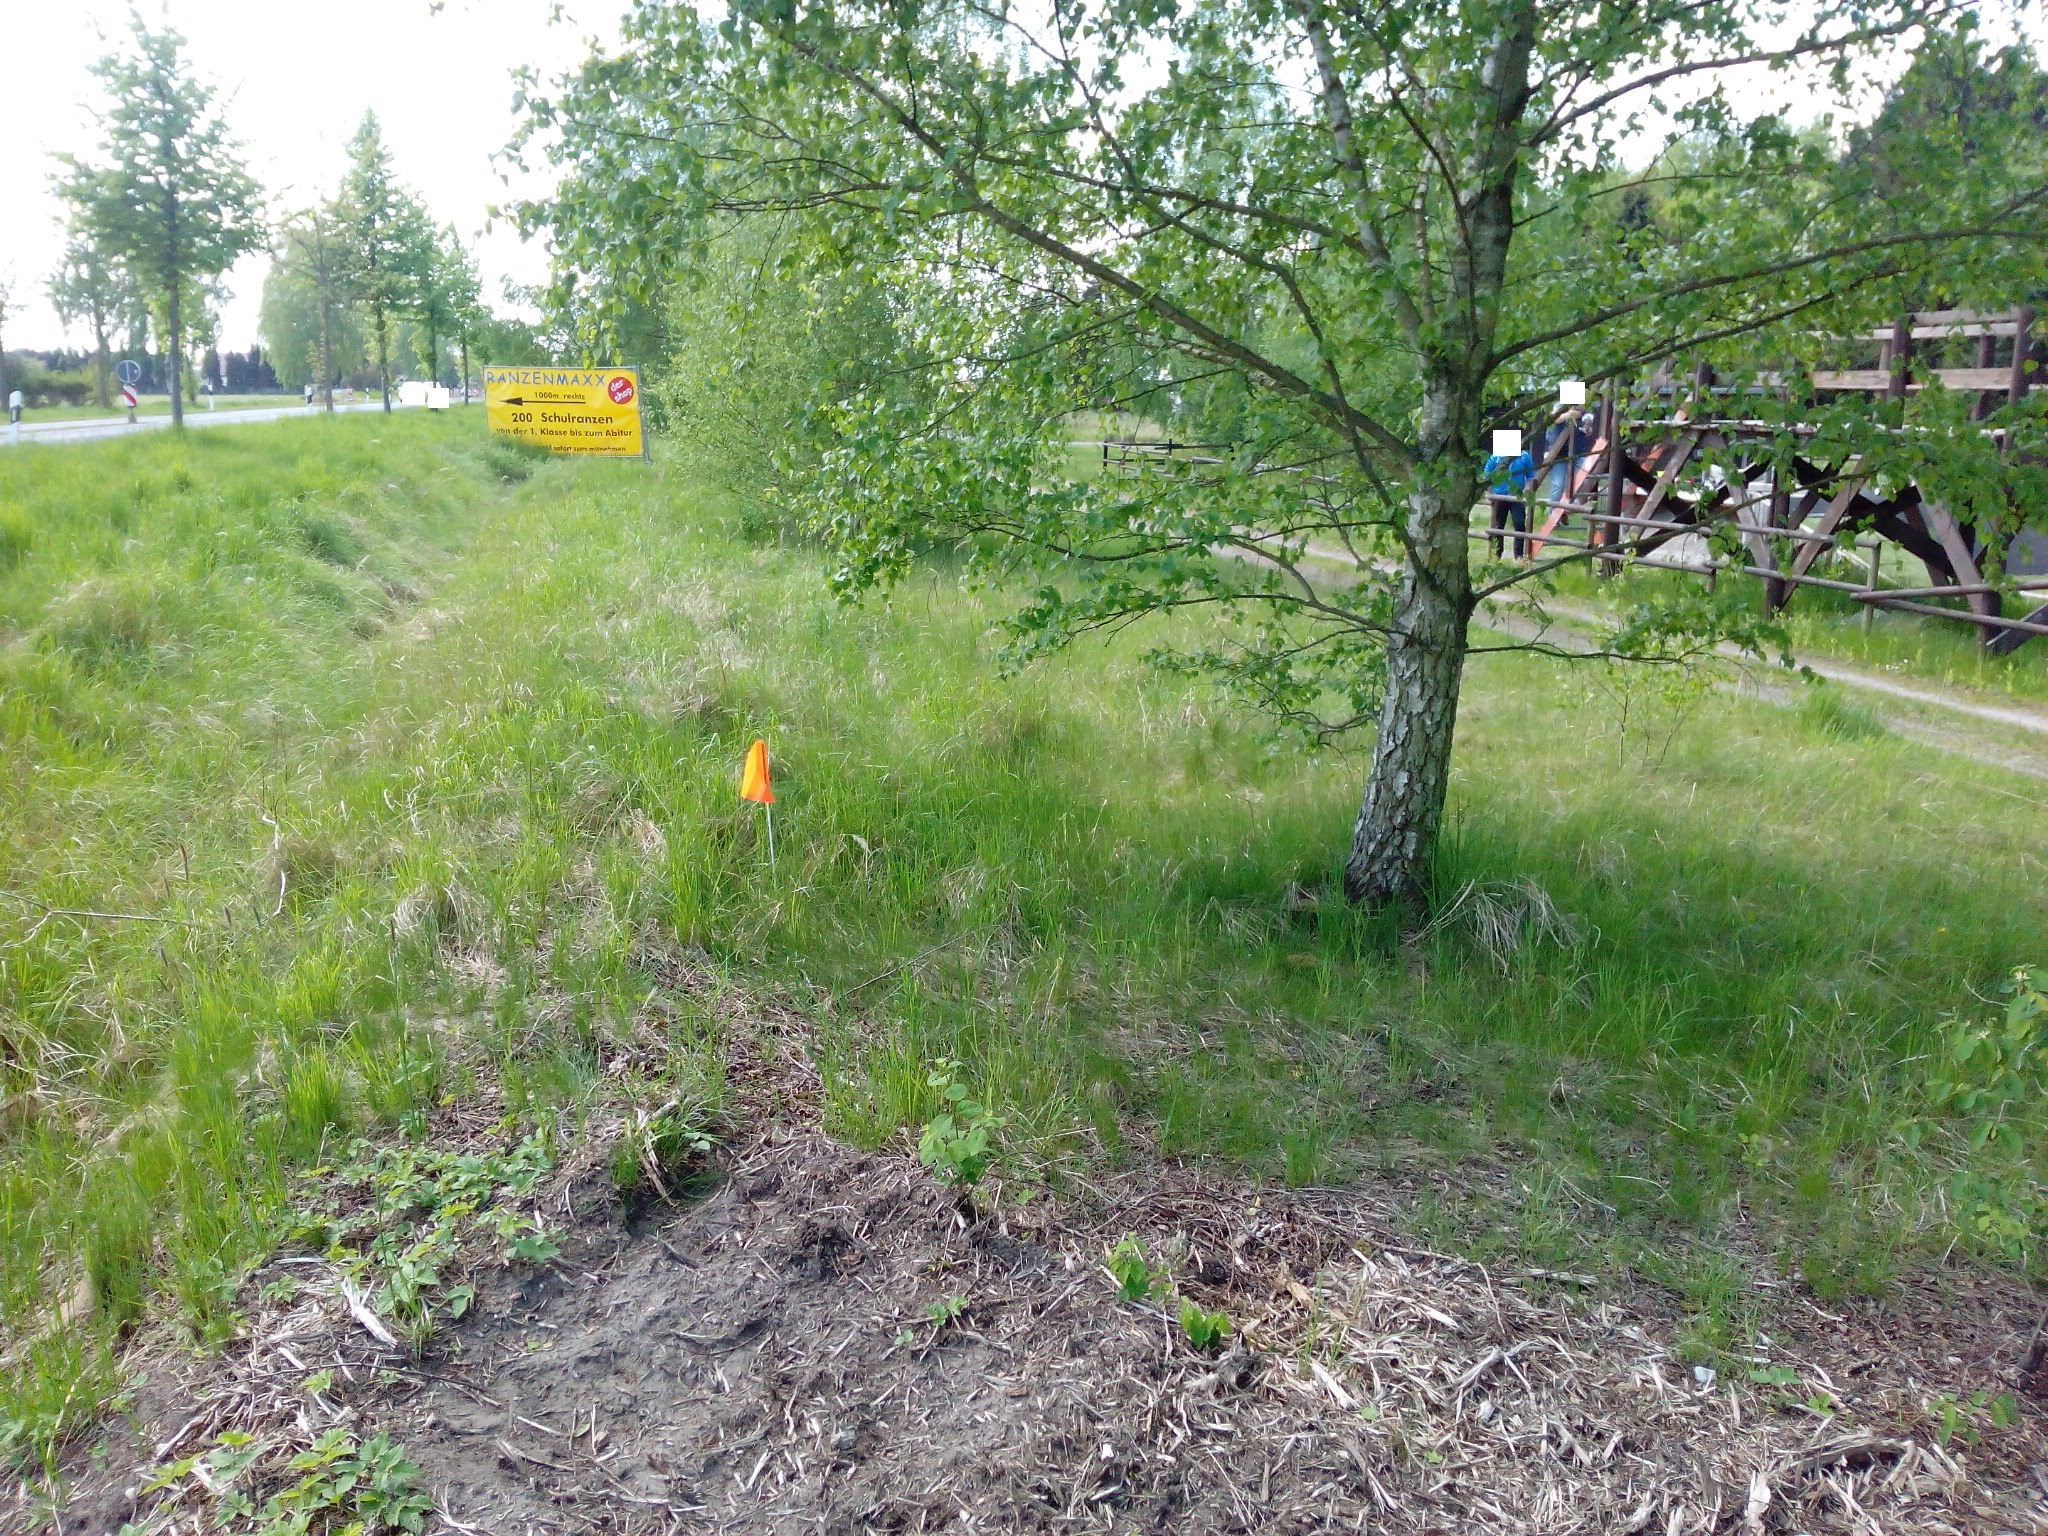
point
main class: Woodland
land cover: Broadleaved woodland
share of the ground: 50 - 75 %
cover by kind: broadleaved forest trees 70 %, herbaceous plants 15 %, consolidated bare surface 15 %
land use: Road transport
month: May
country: DE
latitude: 52.4493
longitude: 9.9265
